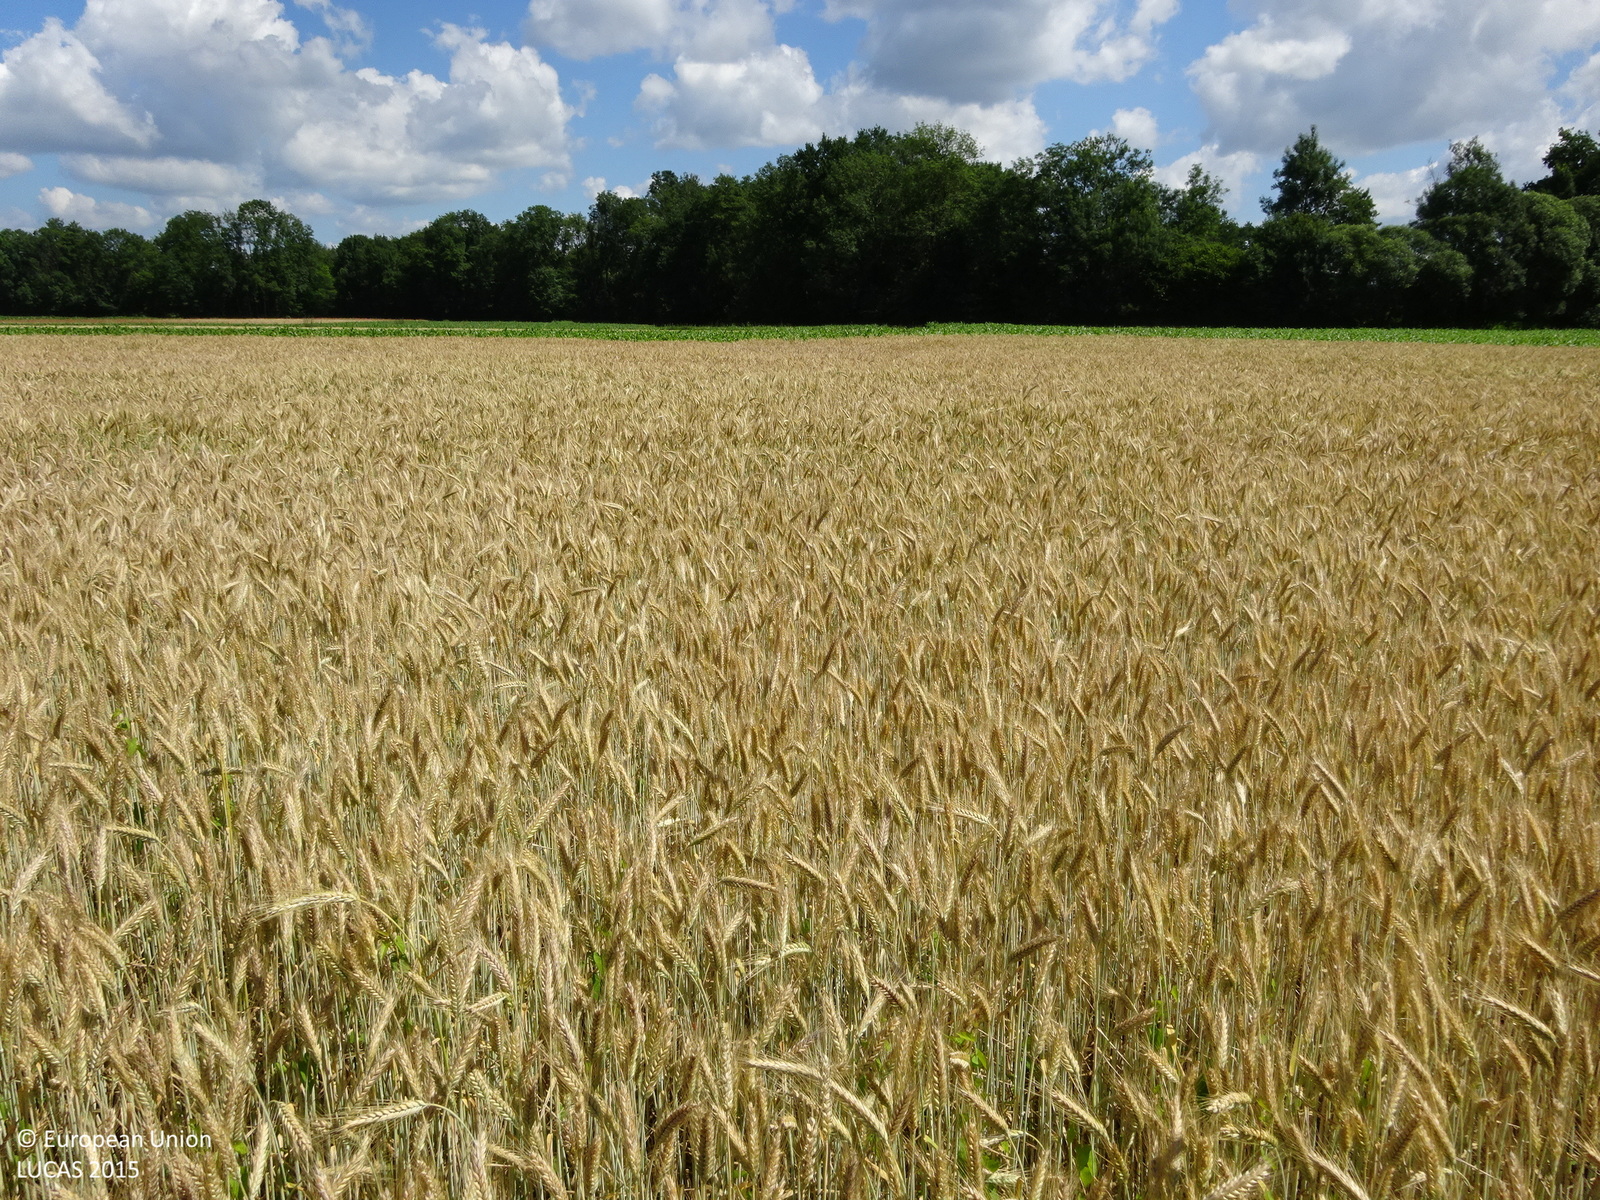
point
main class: Cropland
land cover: Common wheat
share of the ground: > 75 %
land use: Agriculture (excluding fallow land and kitchen gardens)
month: June
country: AT
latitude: 46.7091
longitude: 15.9518
